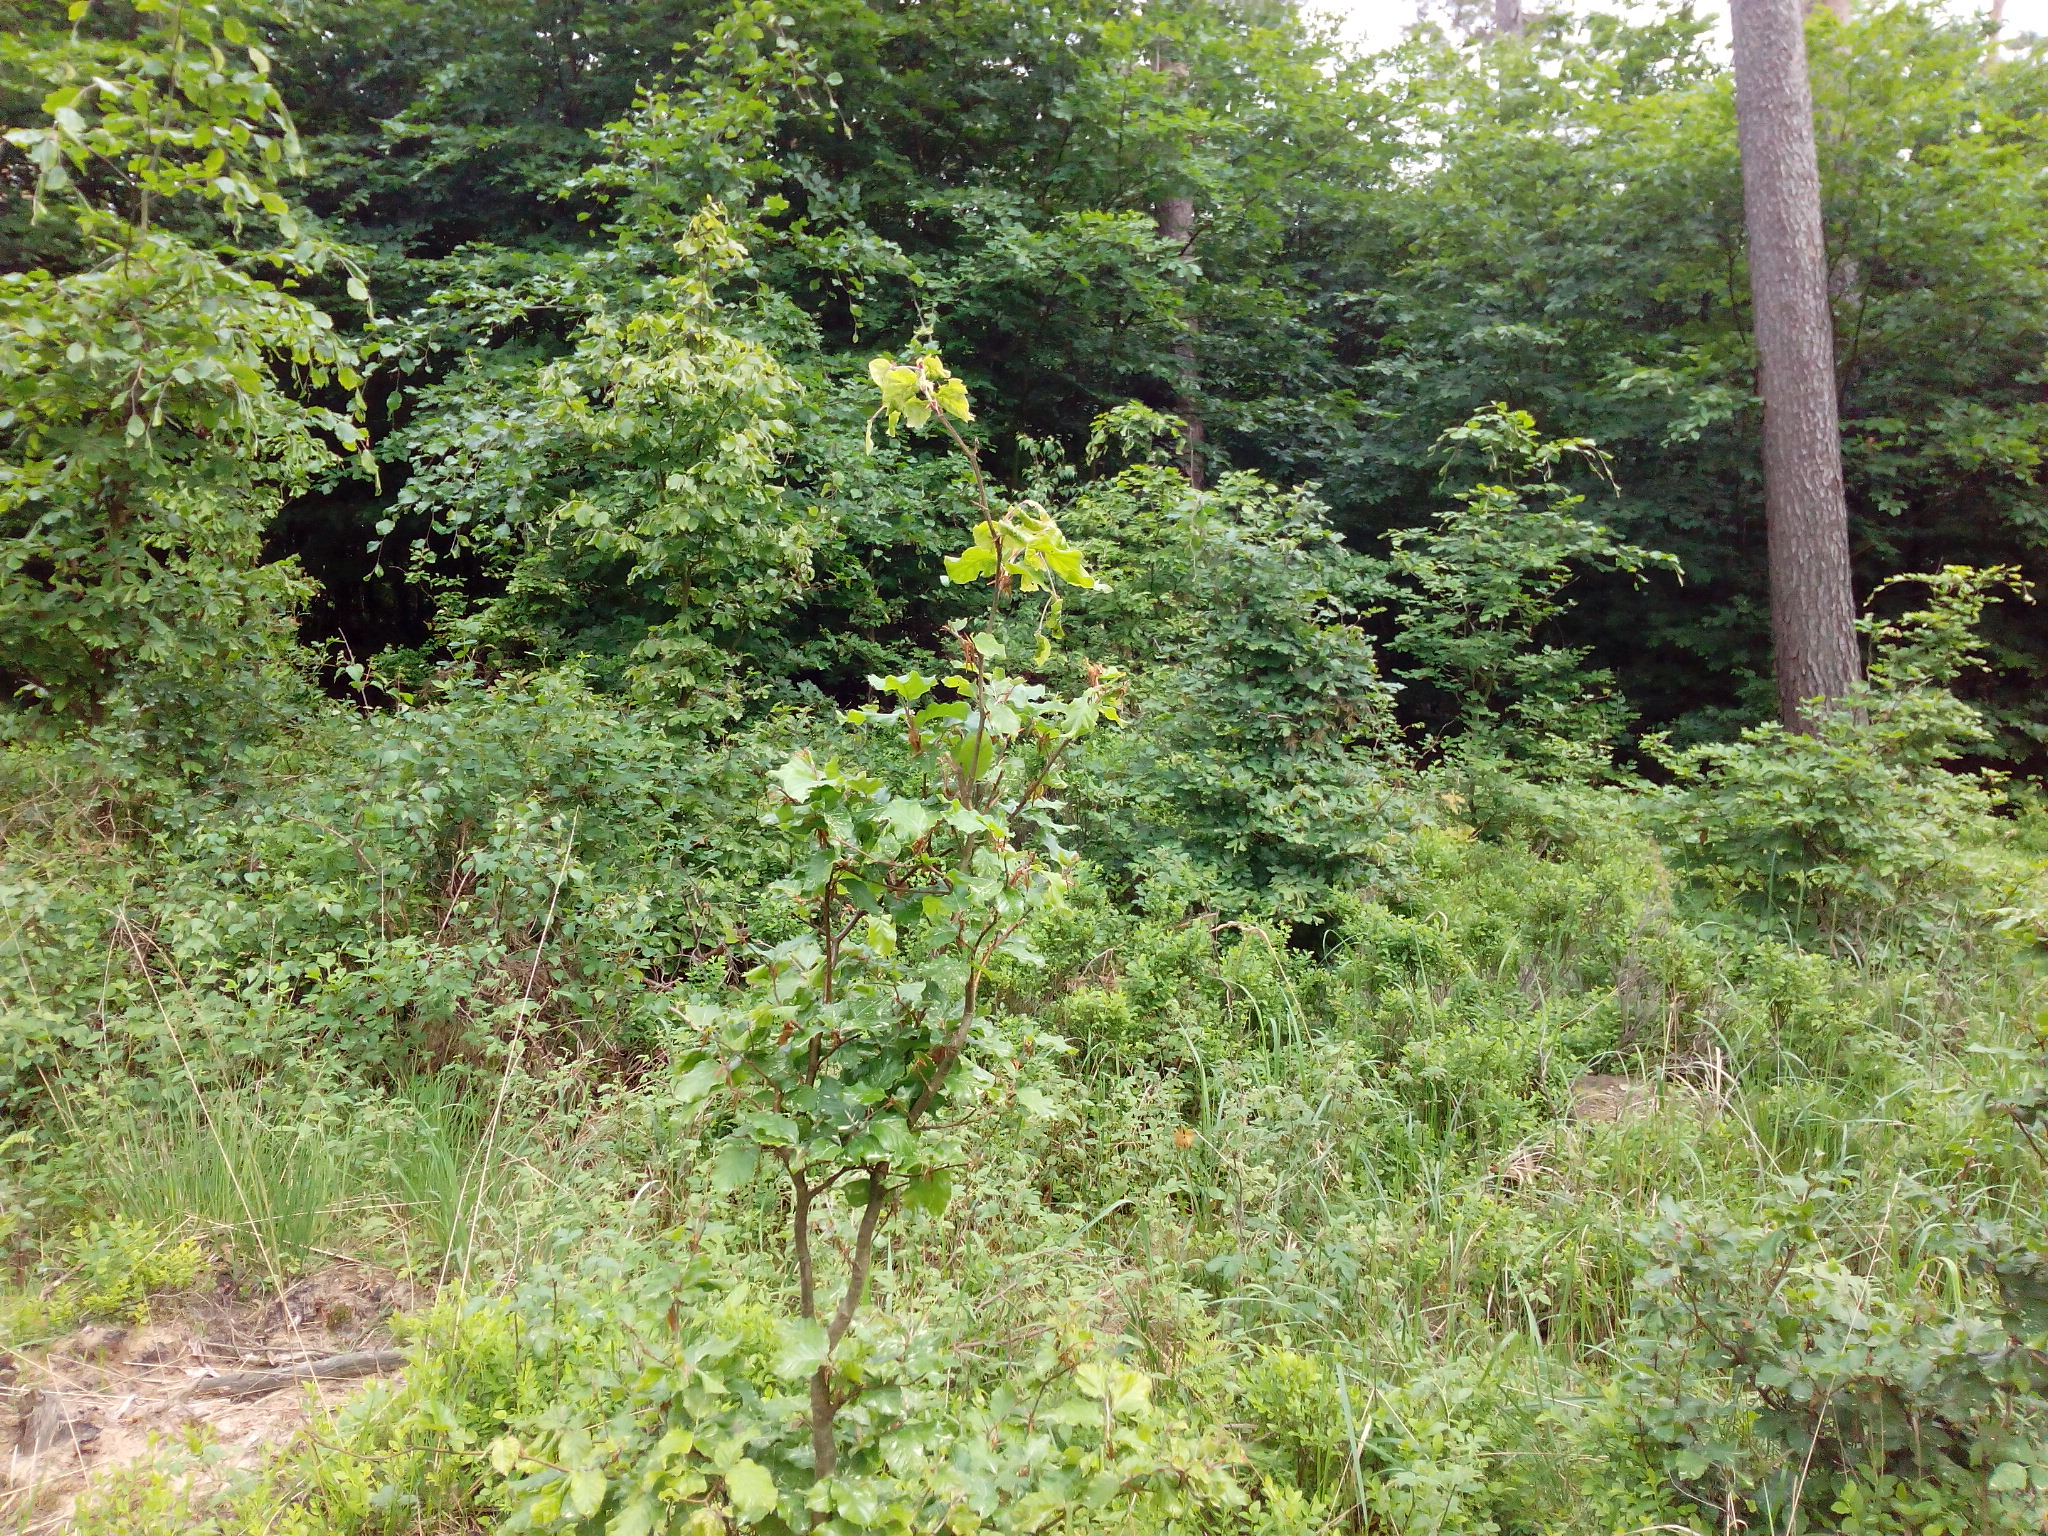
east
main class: Woodland
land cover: Pine dominated mixed woodland
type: hemiboreal forest and nemoral coniferous forest and mixed broadleaved-coniferous forest
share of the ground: > 75 %
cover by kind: coniferous forest trees 50 %, broadleaved forest trees 20 %, shrubs 20 %, herbaceous plants 10 %
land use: Forestry
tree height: > 5 m
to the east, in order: Pine dominated mixed woodland; Tracks; Pine dominated mixed woodland; Tracks; Pine dominated mixed woodland
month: June
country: DE
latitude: 52.6111
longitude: 9.9262
